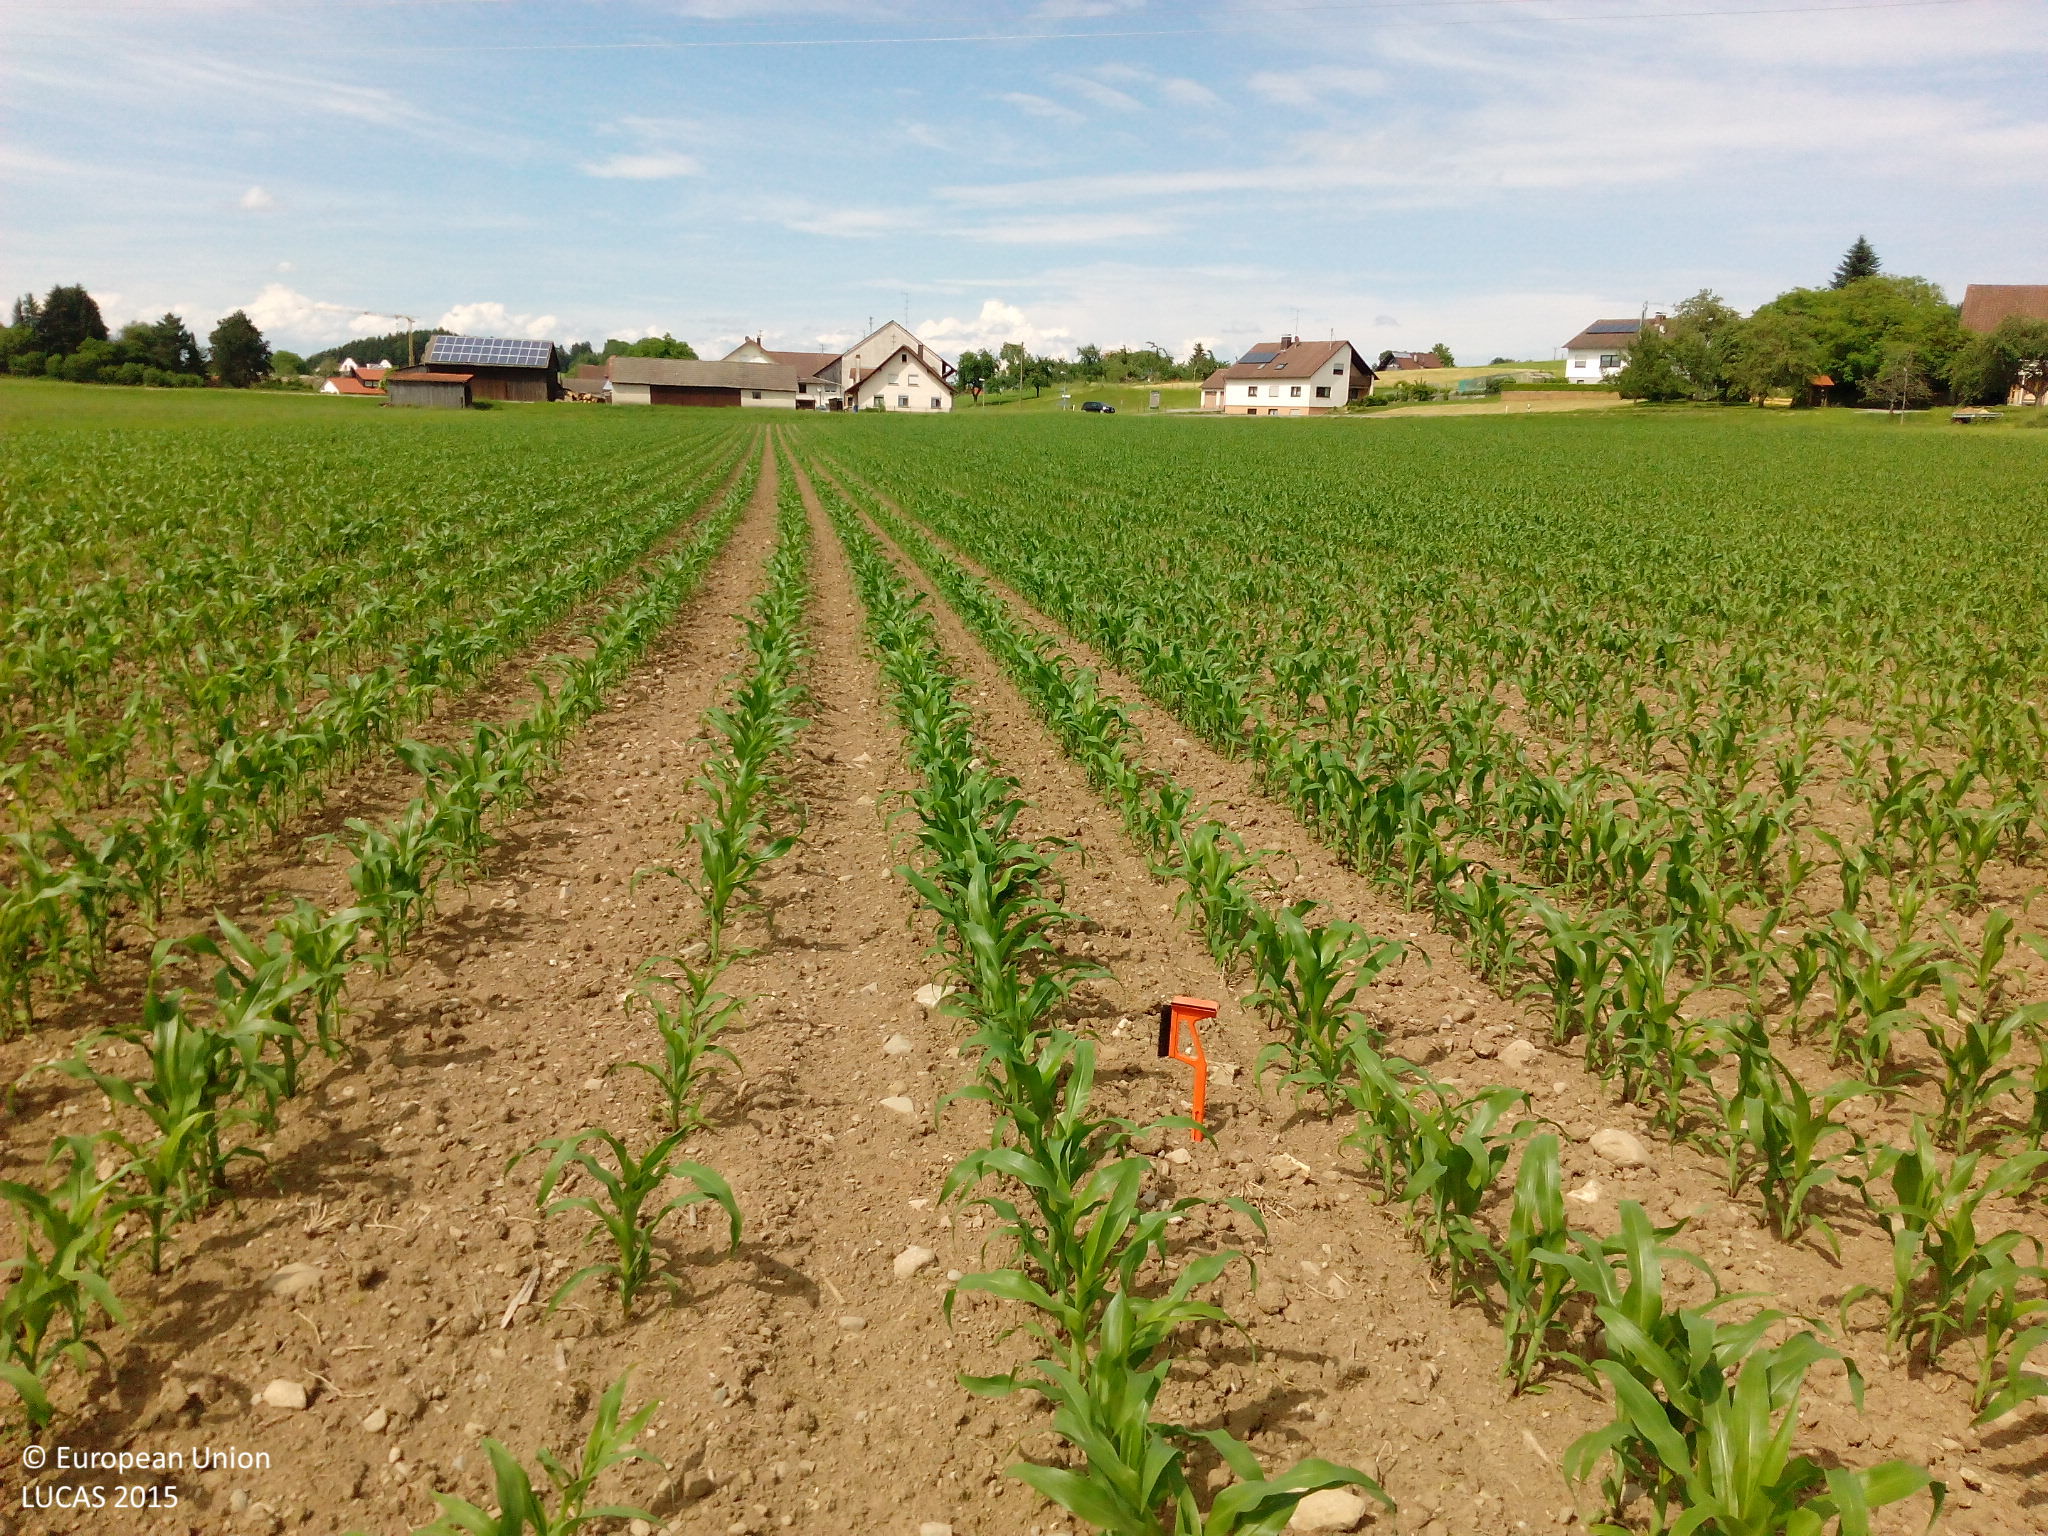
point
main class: Cropland
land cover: Maize
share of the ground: < 10 %
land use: Agriculture (excluding fallow land and kitchen gardens)
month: June
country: DE
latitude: 47.7552
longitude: 9.6934
